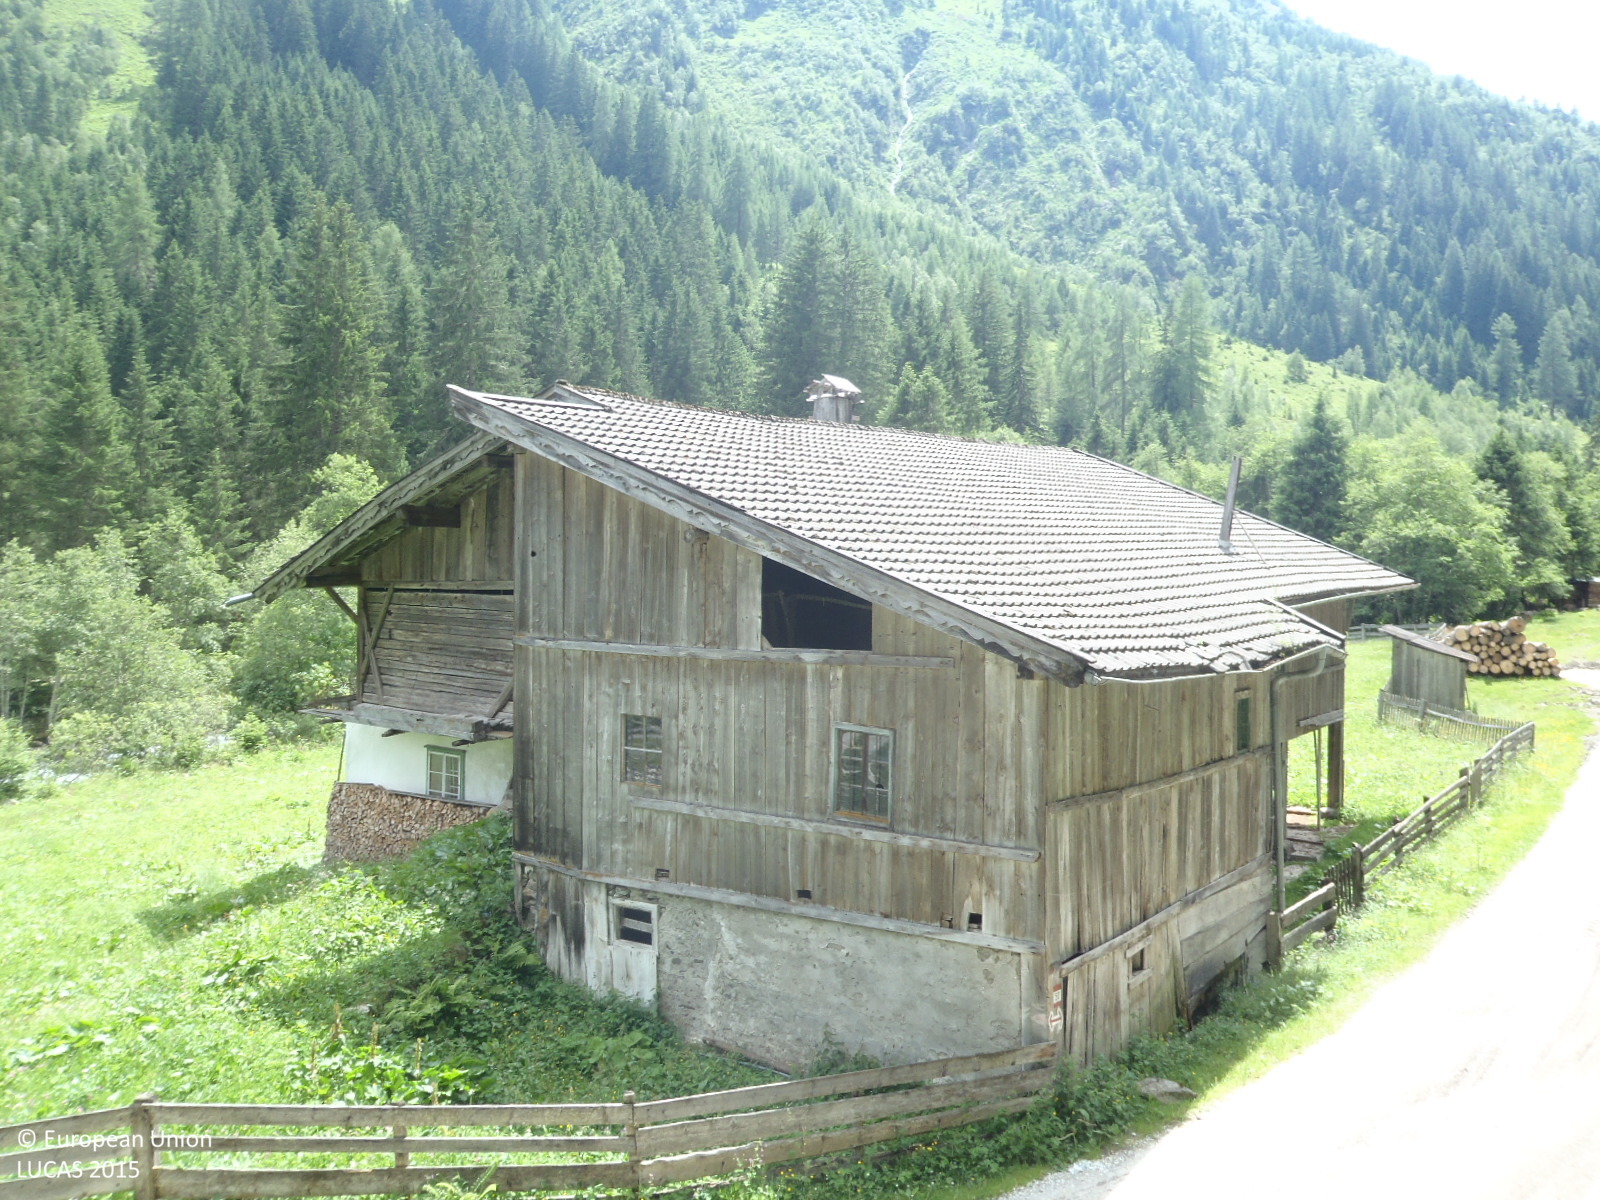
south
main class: Grassland
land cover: Grassland with sparse tree/shrub cover
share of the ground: > 75 %
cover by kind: herbaceous plants 90 %, coniferous forest trees 5 %, shrubs 5 %
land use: Forestry
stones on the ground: 10 - 25 %
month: June
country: AT
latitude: 47.0274
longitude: 11.3276
